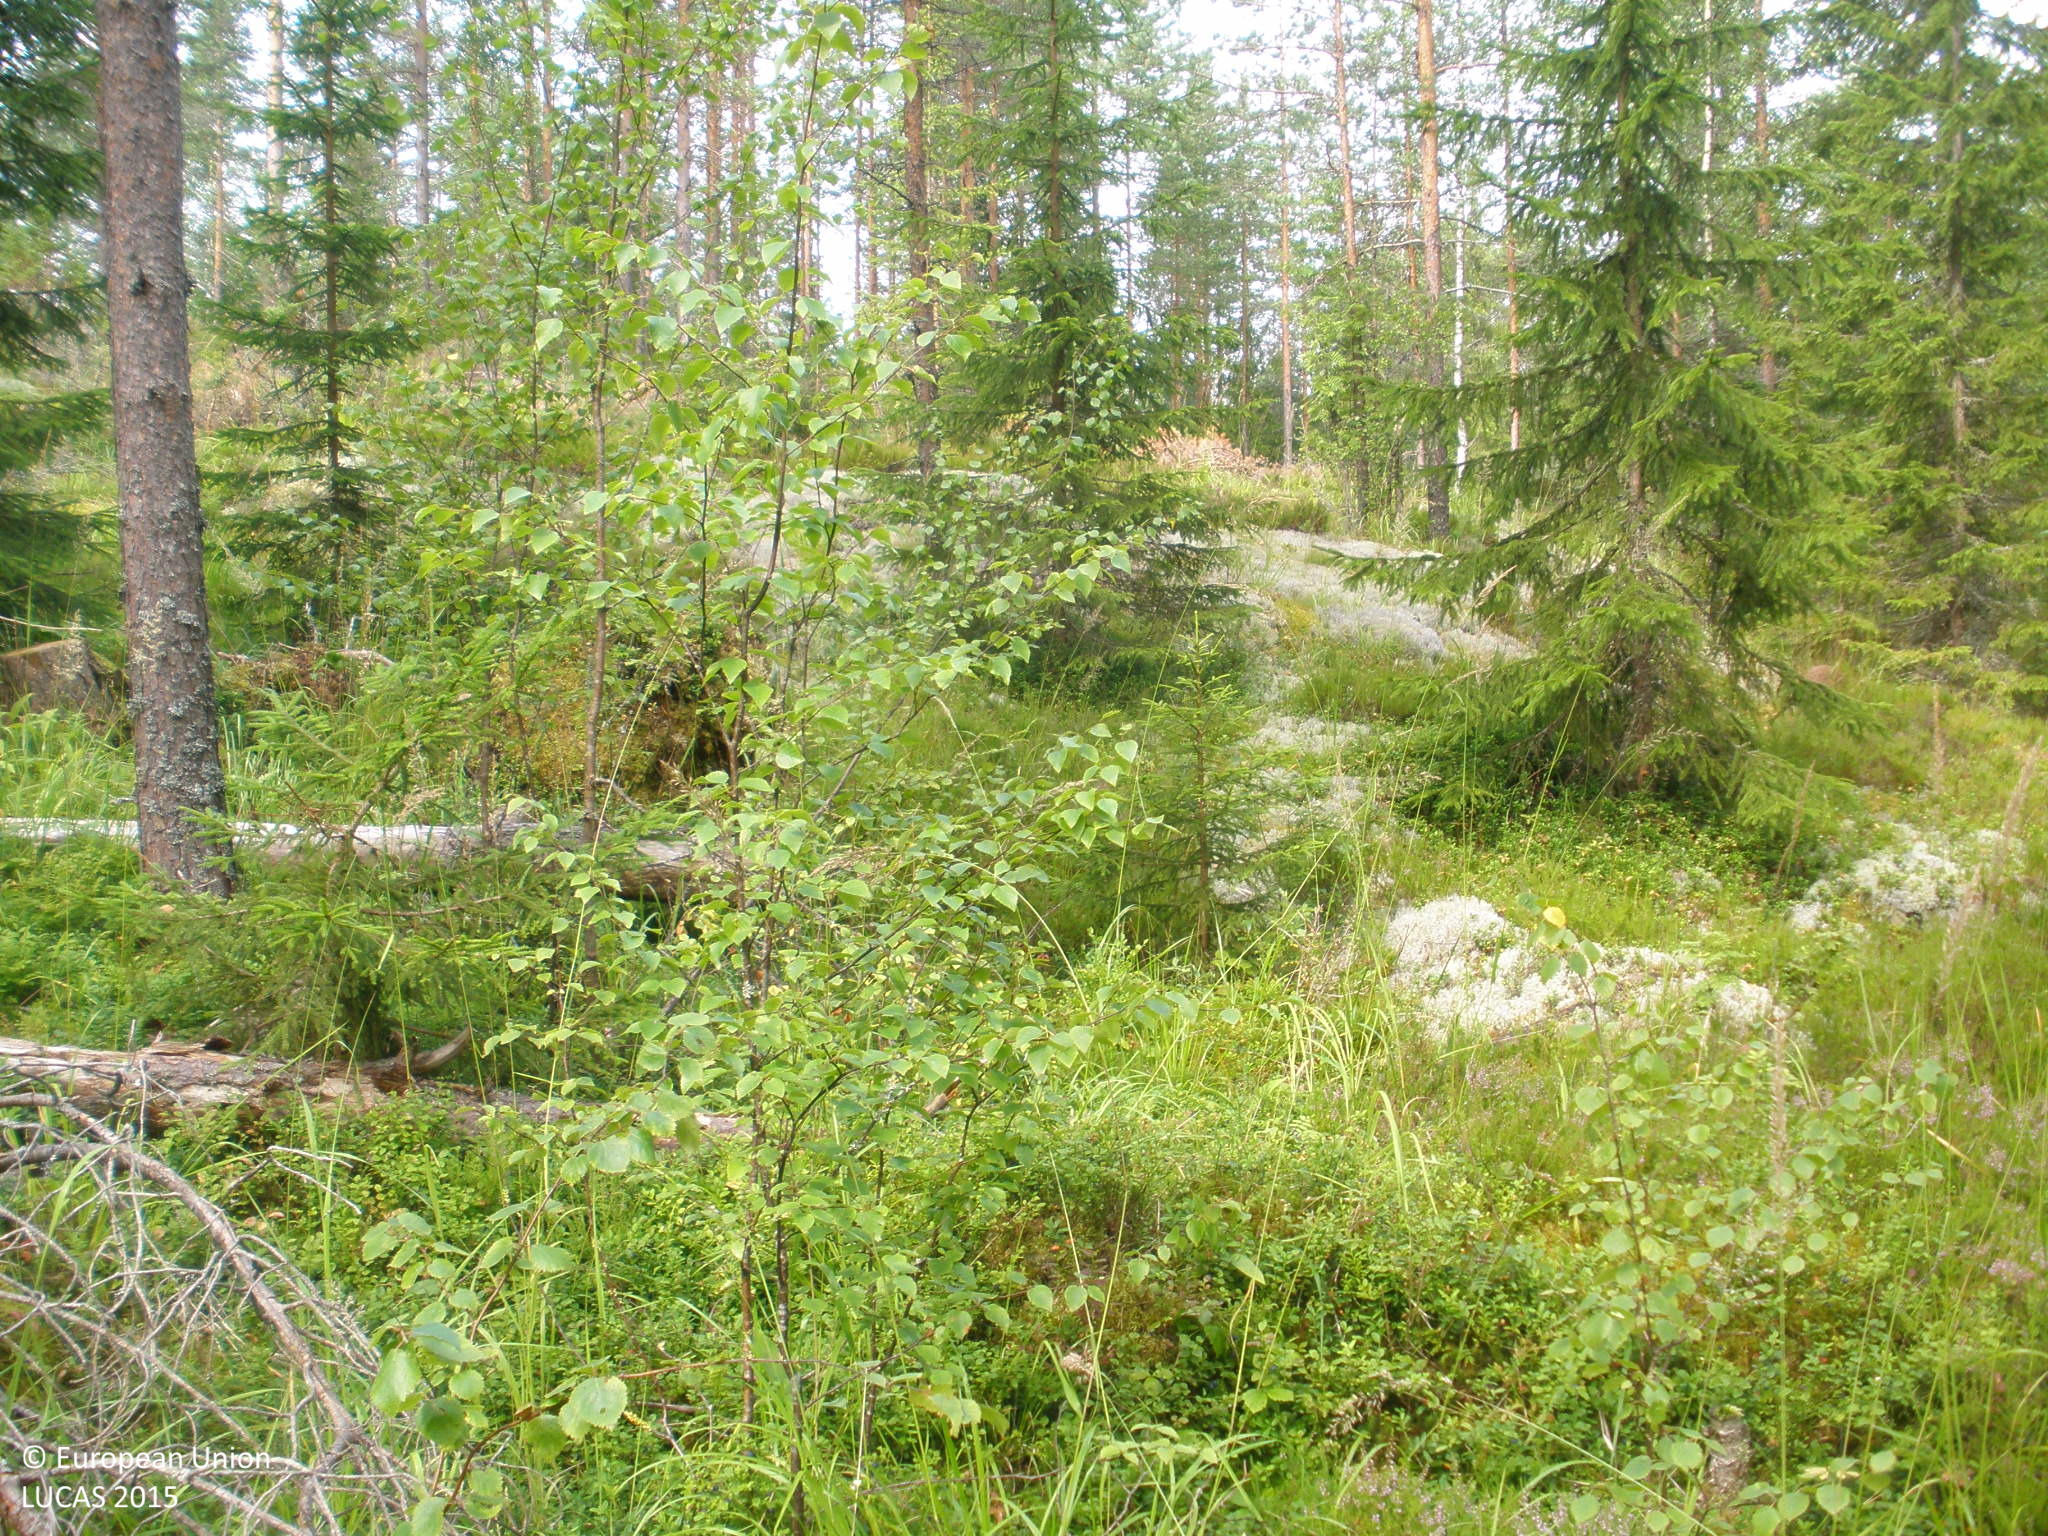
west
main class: Woodland
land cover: Pine dominated coniferous woodland
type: boreal forest
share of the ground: > 75 %
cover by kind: coniferous forest trees 75 %, herbaceous plants 10 %, lichens and mosses 10 %, shrubs 5 %
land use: Forestry
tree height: > 5 m
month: August
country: FI
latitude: 60.6107
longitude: 24.0343
